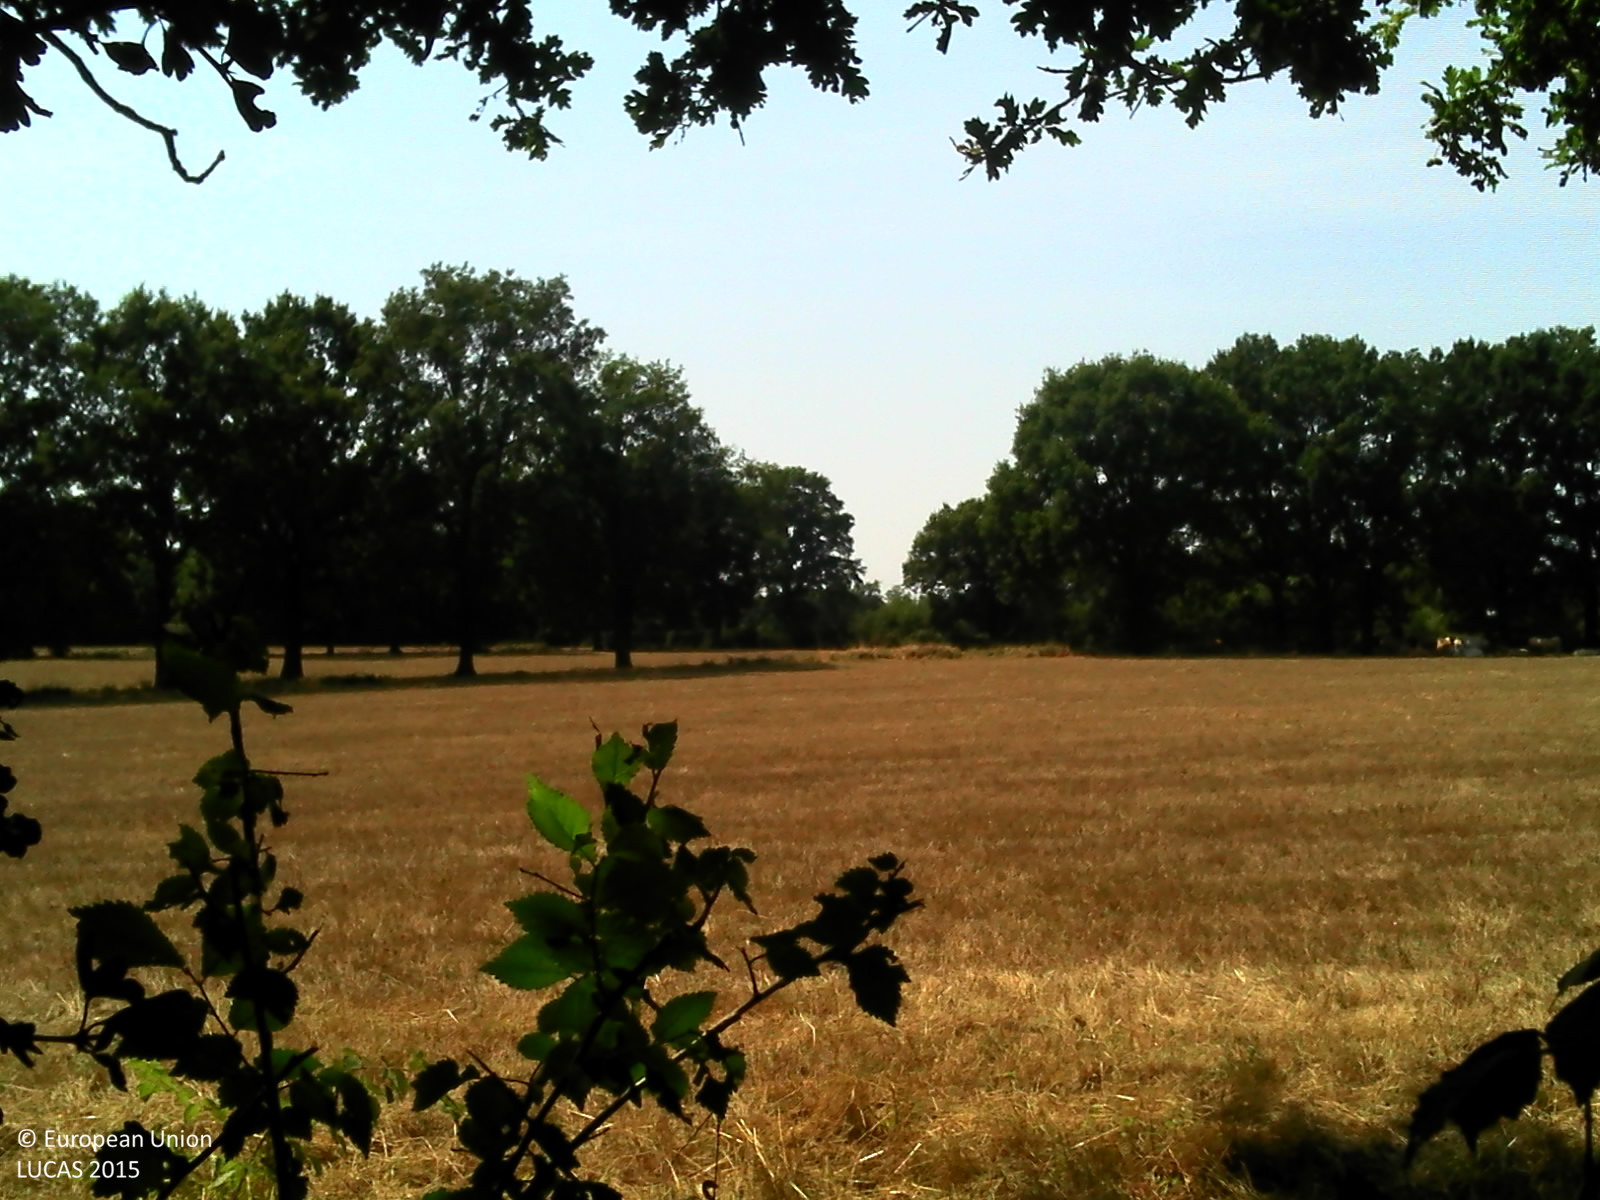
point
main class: Grassland
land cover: Grassland without tree/shrub cover
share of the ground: > 75 %
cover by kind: herbaceous plants 100 %
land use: Agriculture (excluding fallow land and kitchen gardens)
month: August
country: FR
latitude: 46.7684
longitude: 2.9380
